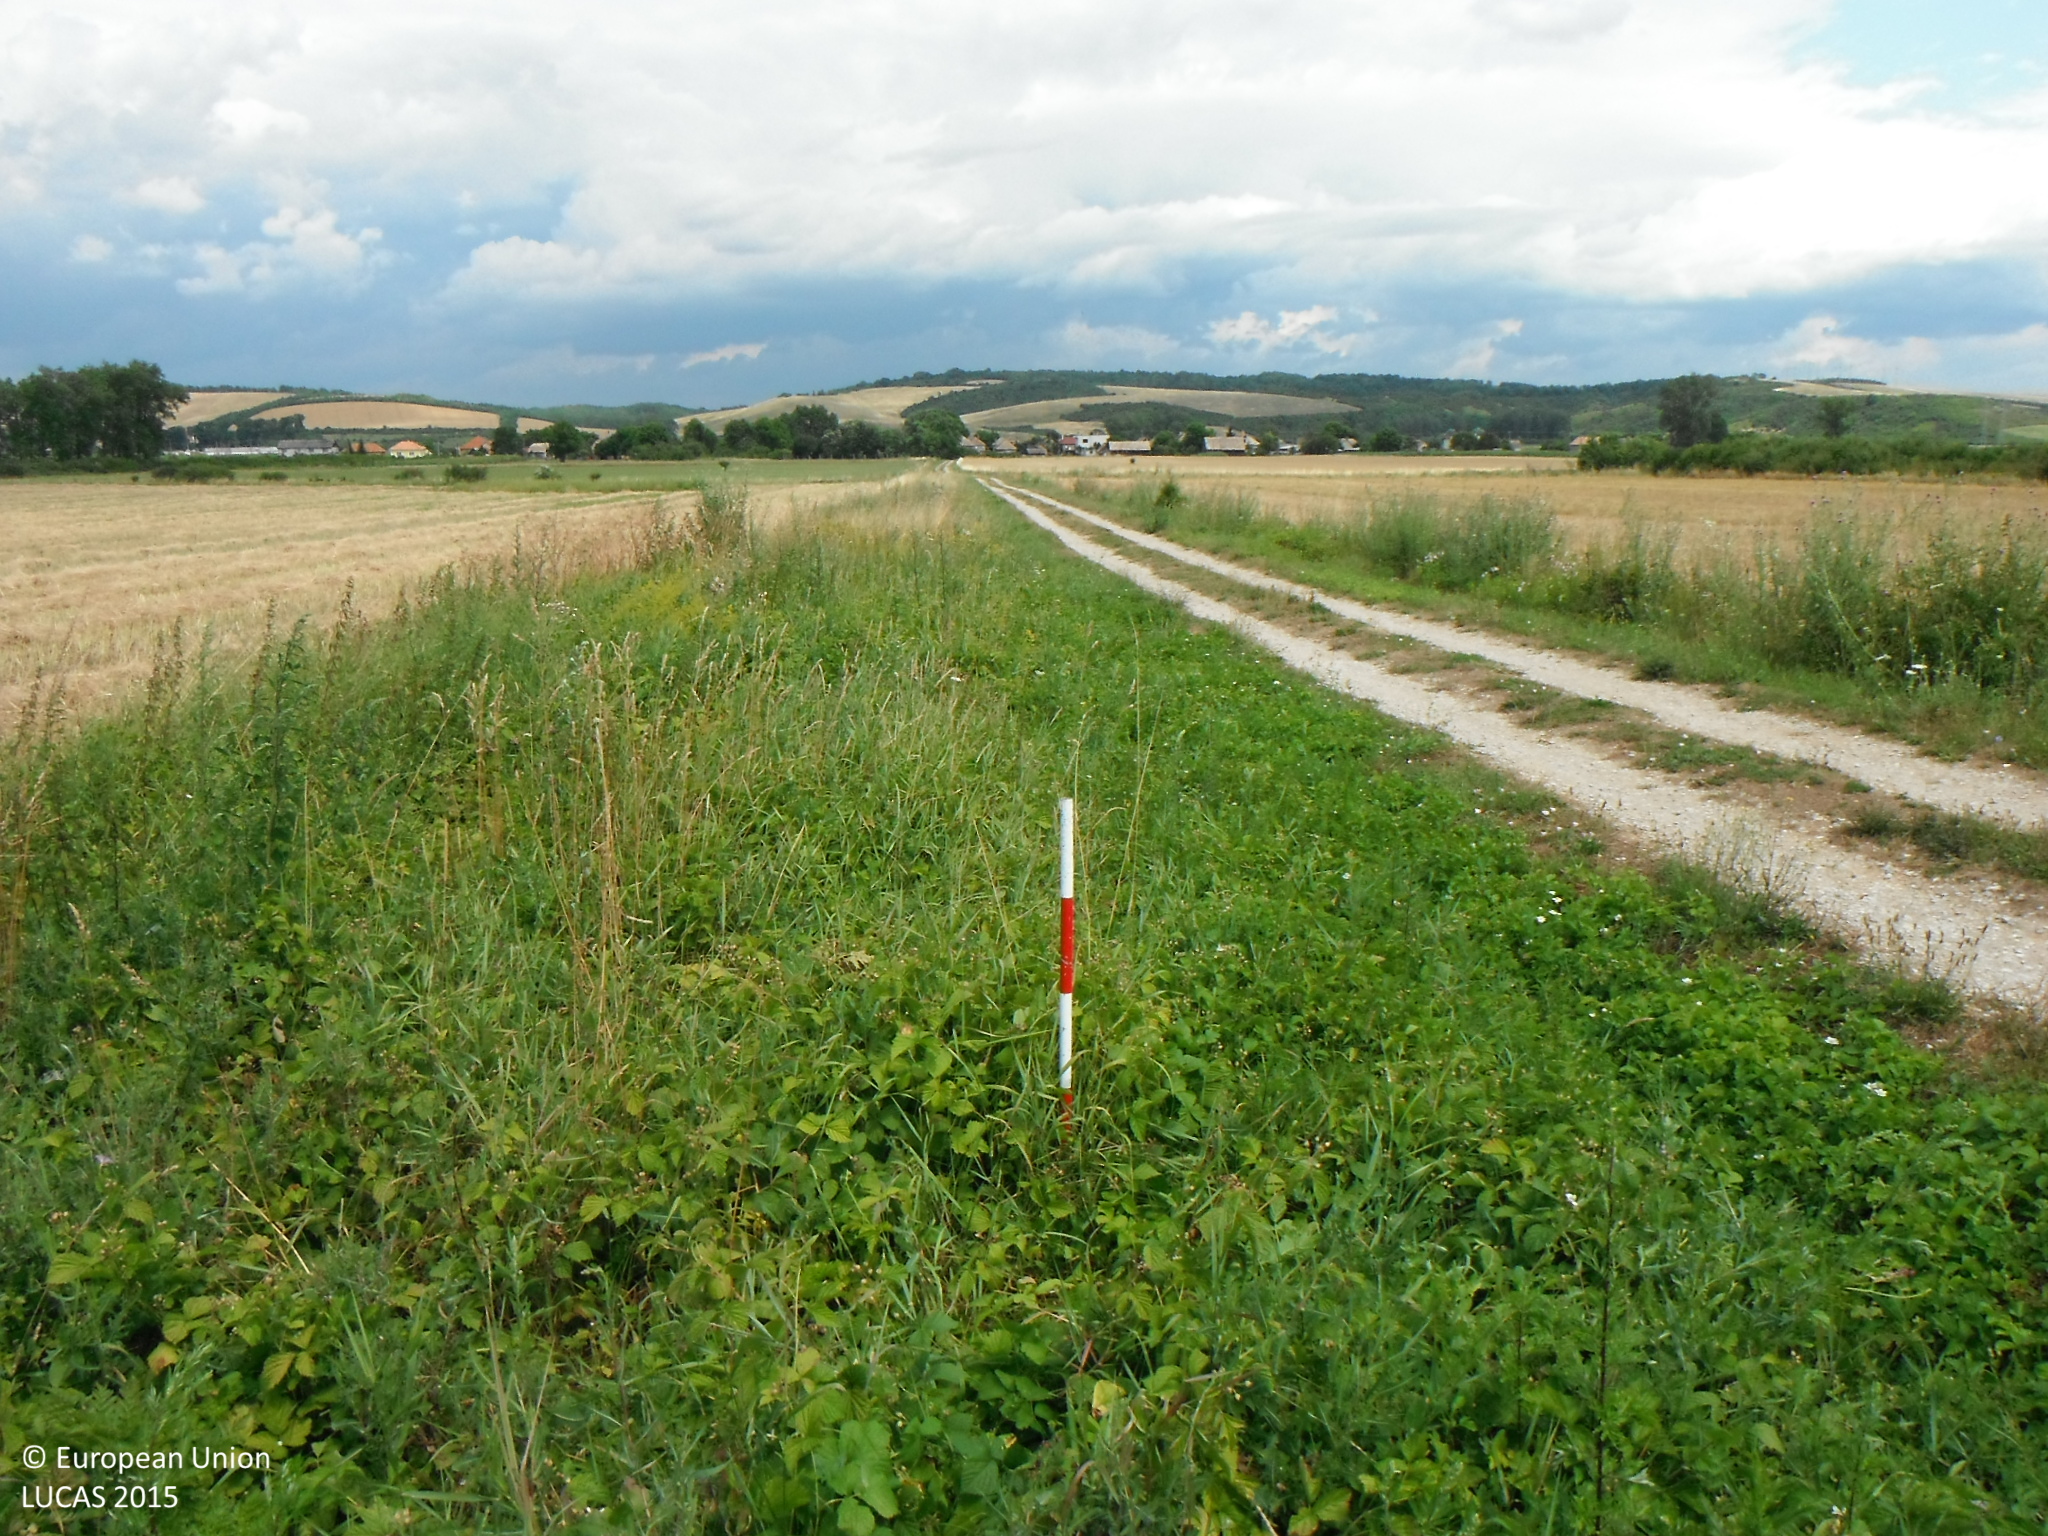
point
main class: Grassland
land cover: Spontaneously vegetated surfaces
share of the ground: > 75 %
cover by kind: herbaceous plants 100 %
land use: Semi-natural and natural areas not in use
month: July
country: SK
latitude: 48.3484
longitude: 20.1917
